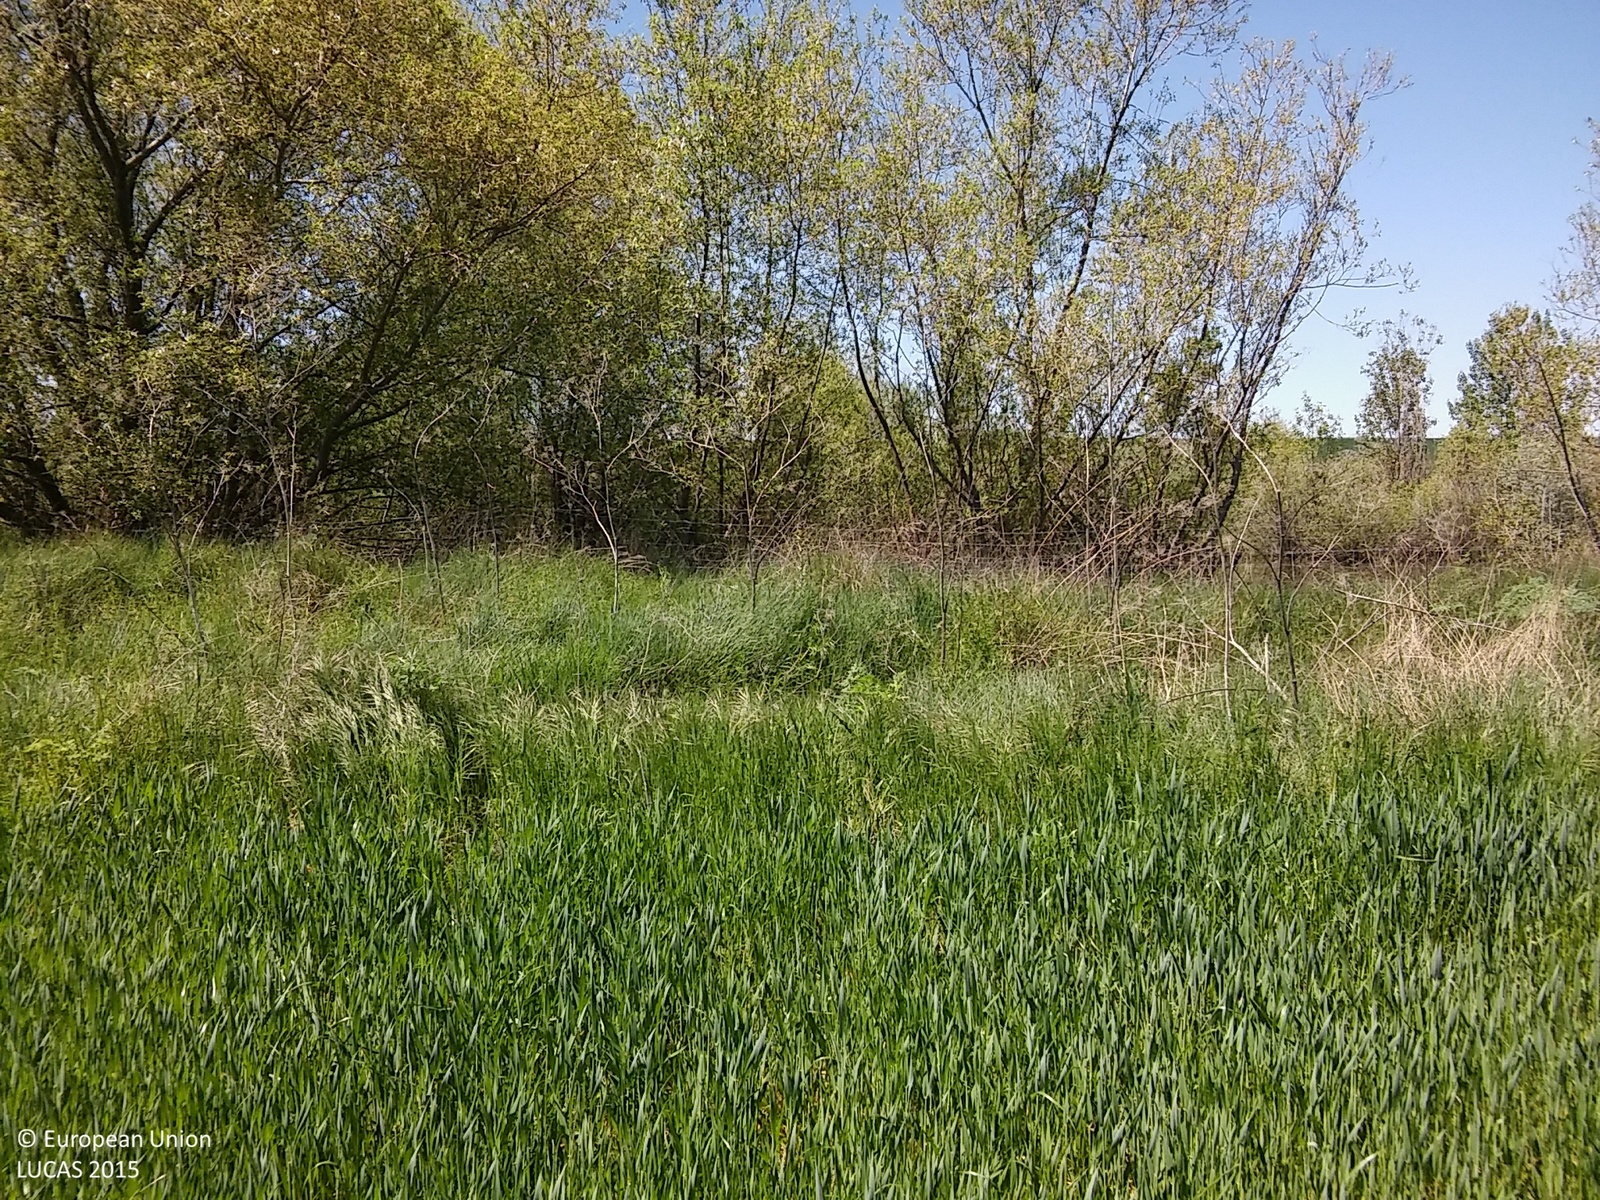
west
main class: Cropland
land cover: Common wheat
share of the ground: > 75 %
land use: Agriculture (excluding fallow land and kitchen gardens)
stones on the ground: < 10 %
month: May
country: ES
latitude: 41.1516
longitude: -3.9562
